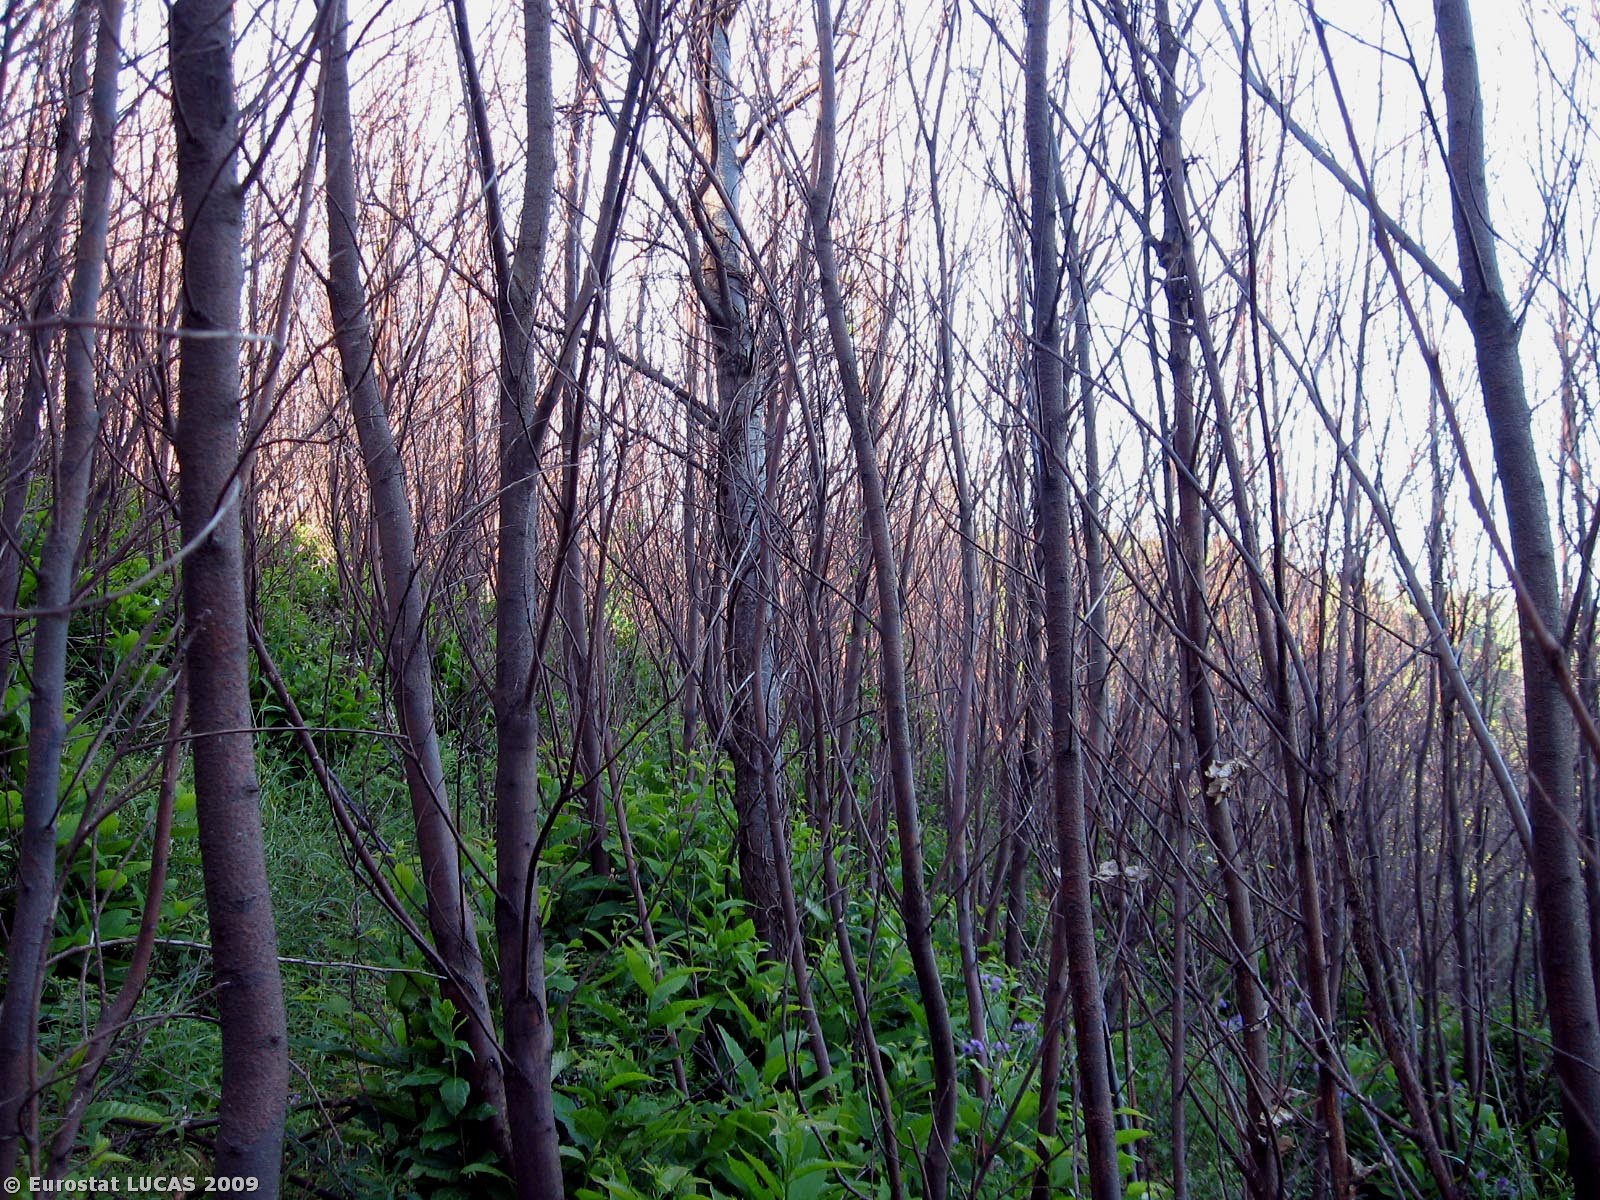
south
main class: Woodland
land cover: Broadleaved woodland
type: thermophilous deciduous forest
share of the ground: 25 - 50 %
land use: Forestry
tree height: > 5 m
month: June
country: IT
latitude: 38.8228
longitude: 16.4045
